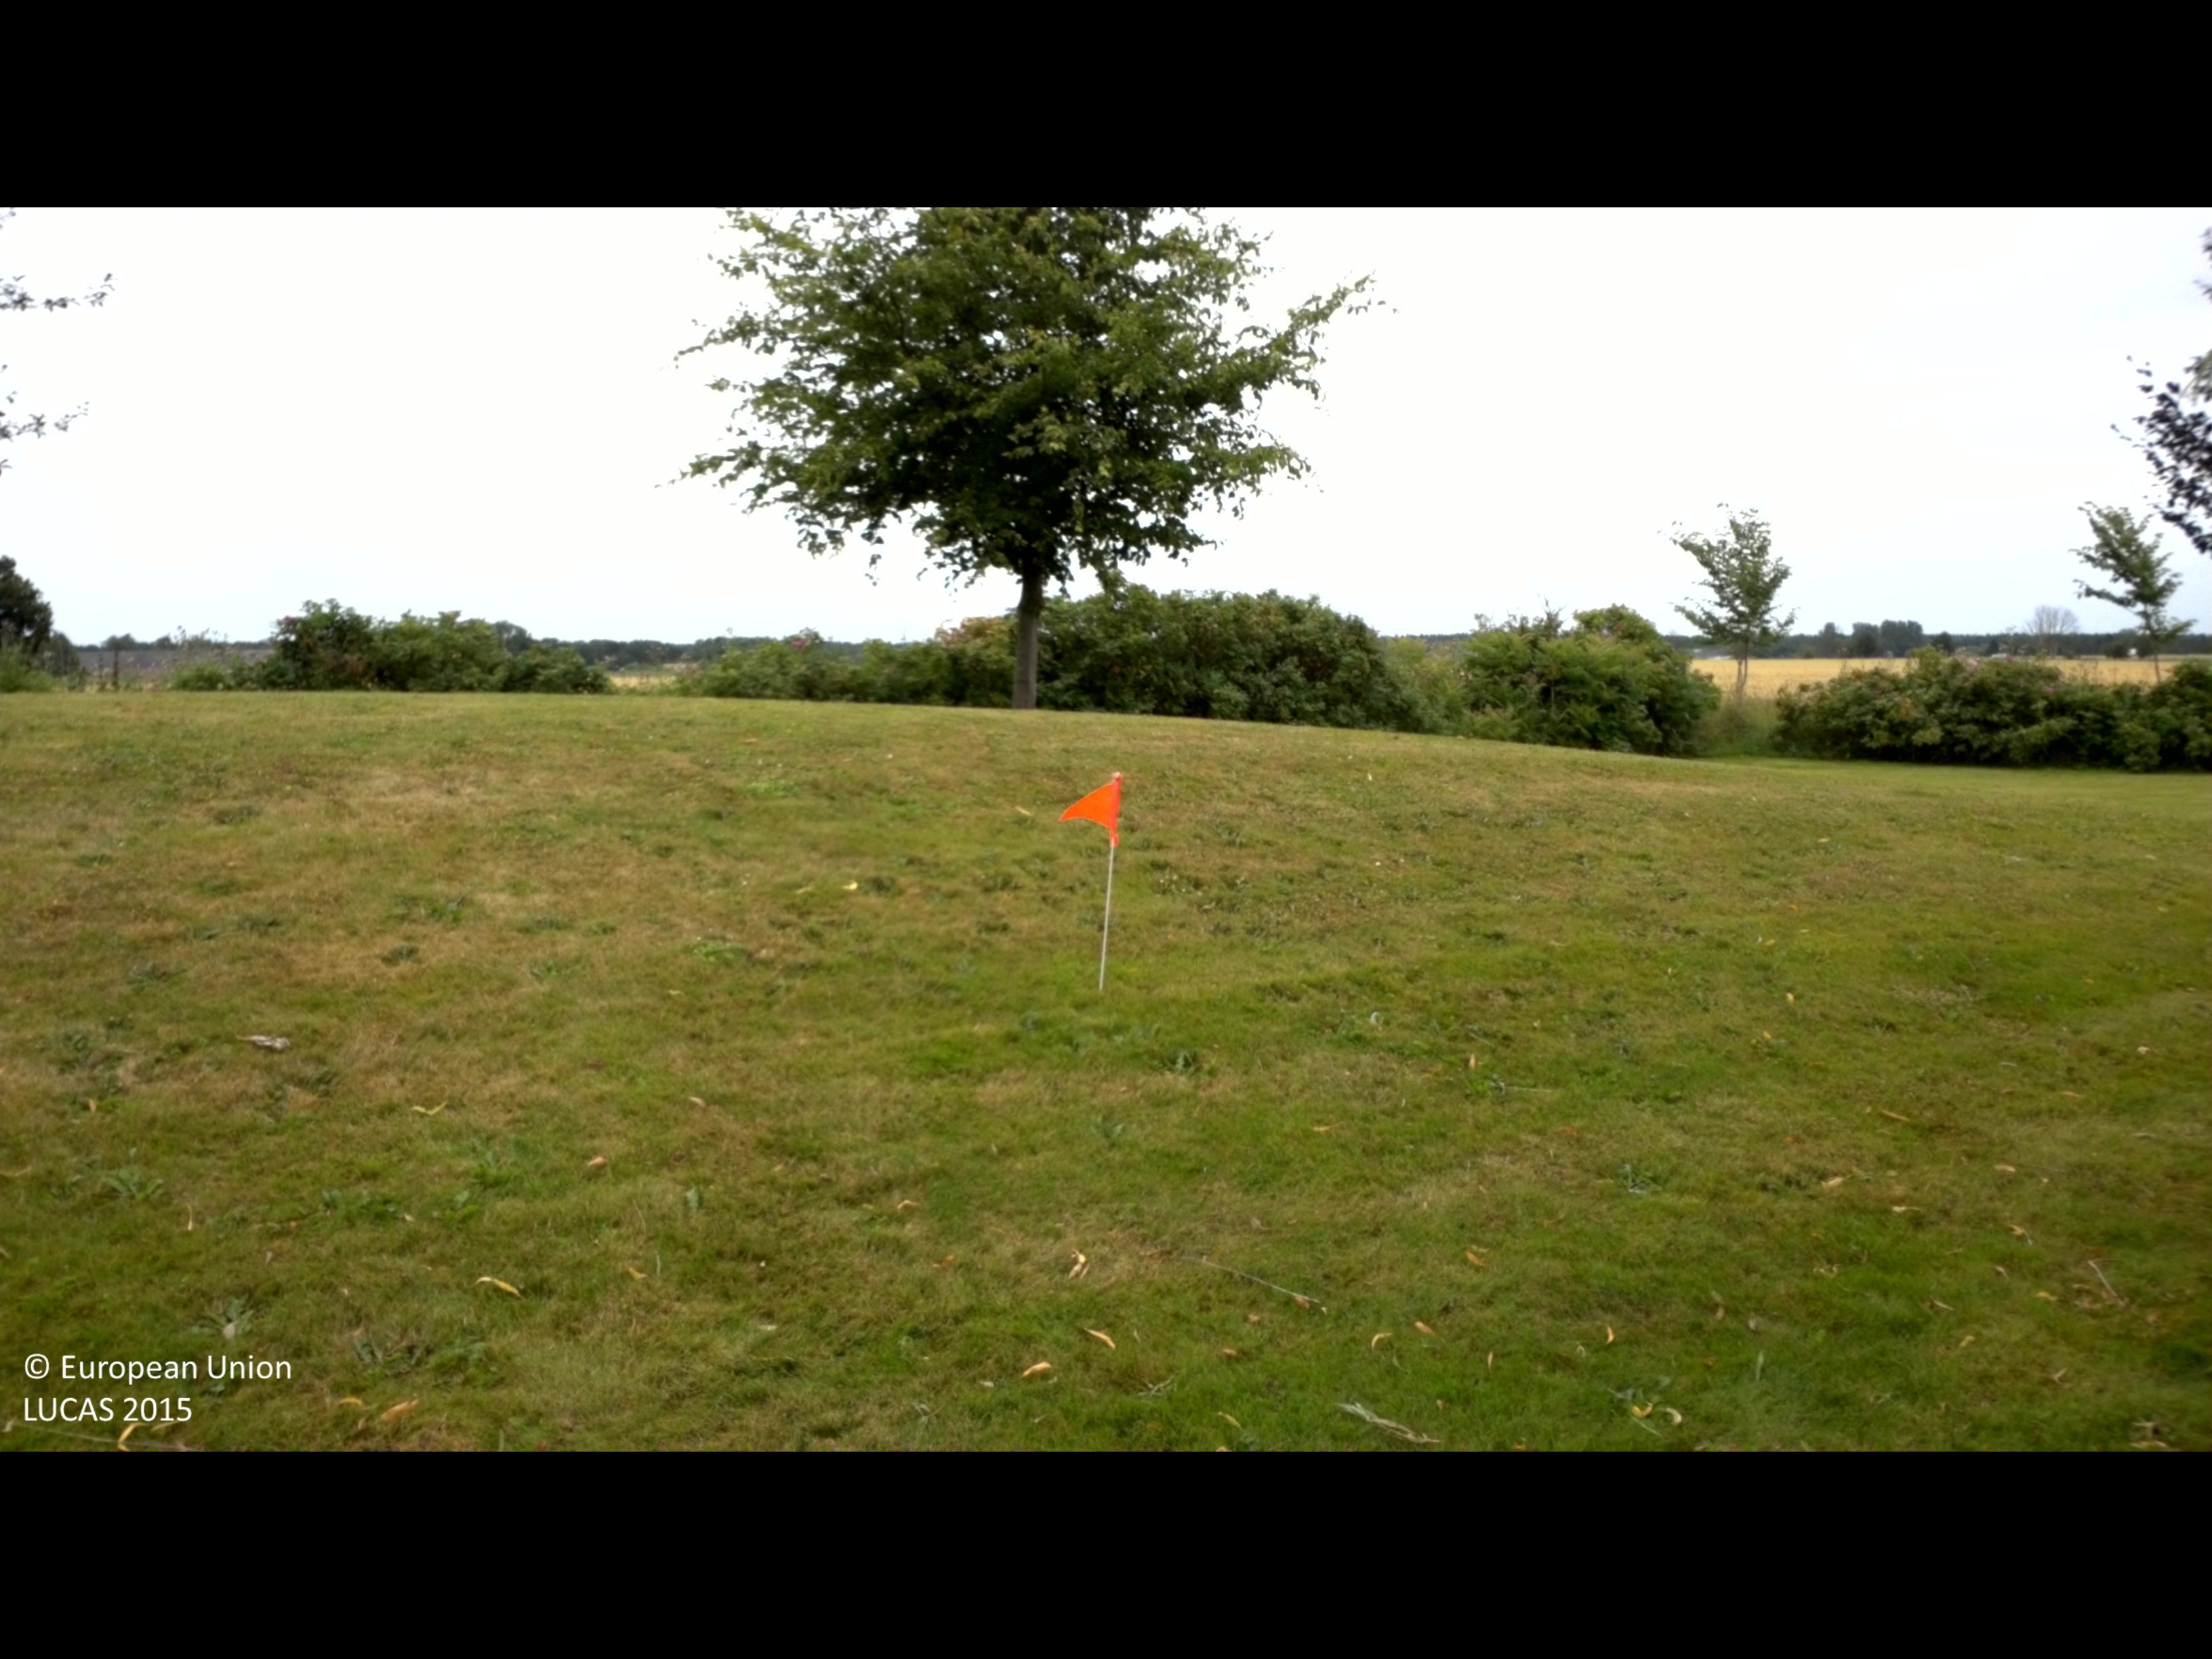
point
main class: Grassland
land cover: Grassland with sparse tree/shrub cover
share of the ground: > 75 %
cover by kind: herbaceous plants 95 %, broadleaved forest trees 5 %
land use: Community services
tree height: < 5 m
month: July
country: SE
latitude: 55.8891
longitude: 14.0752
